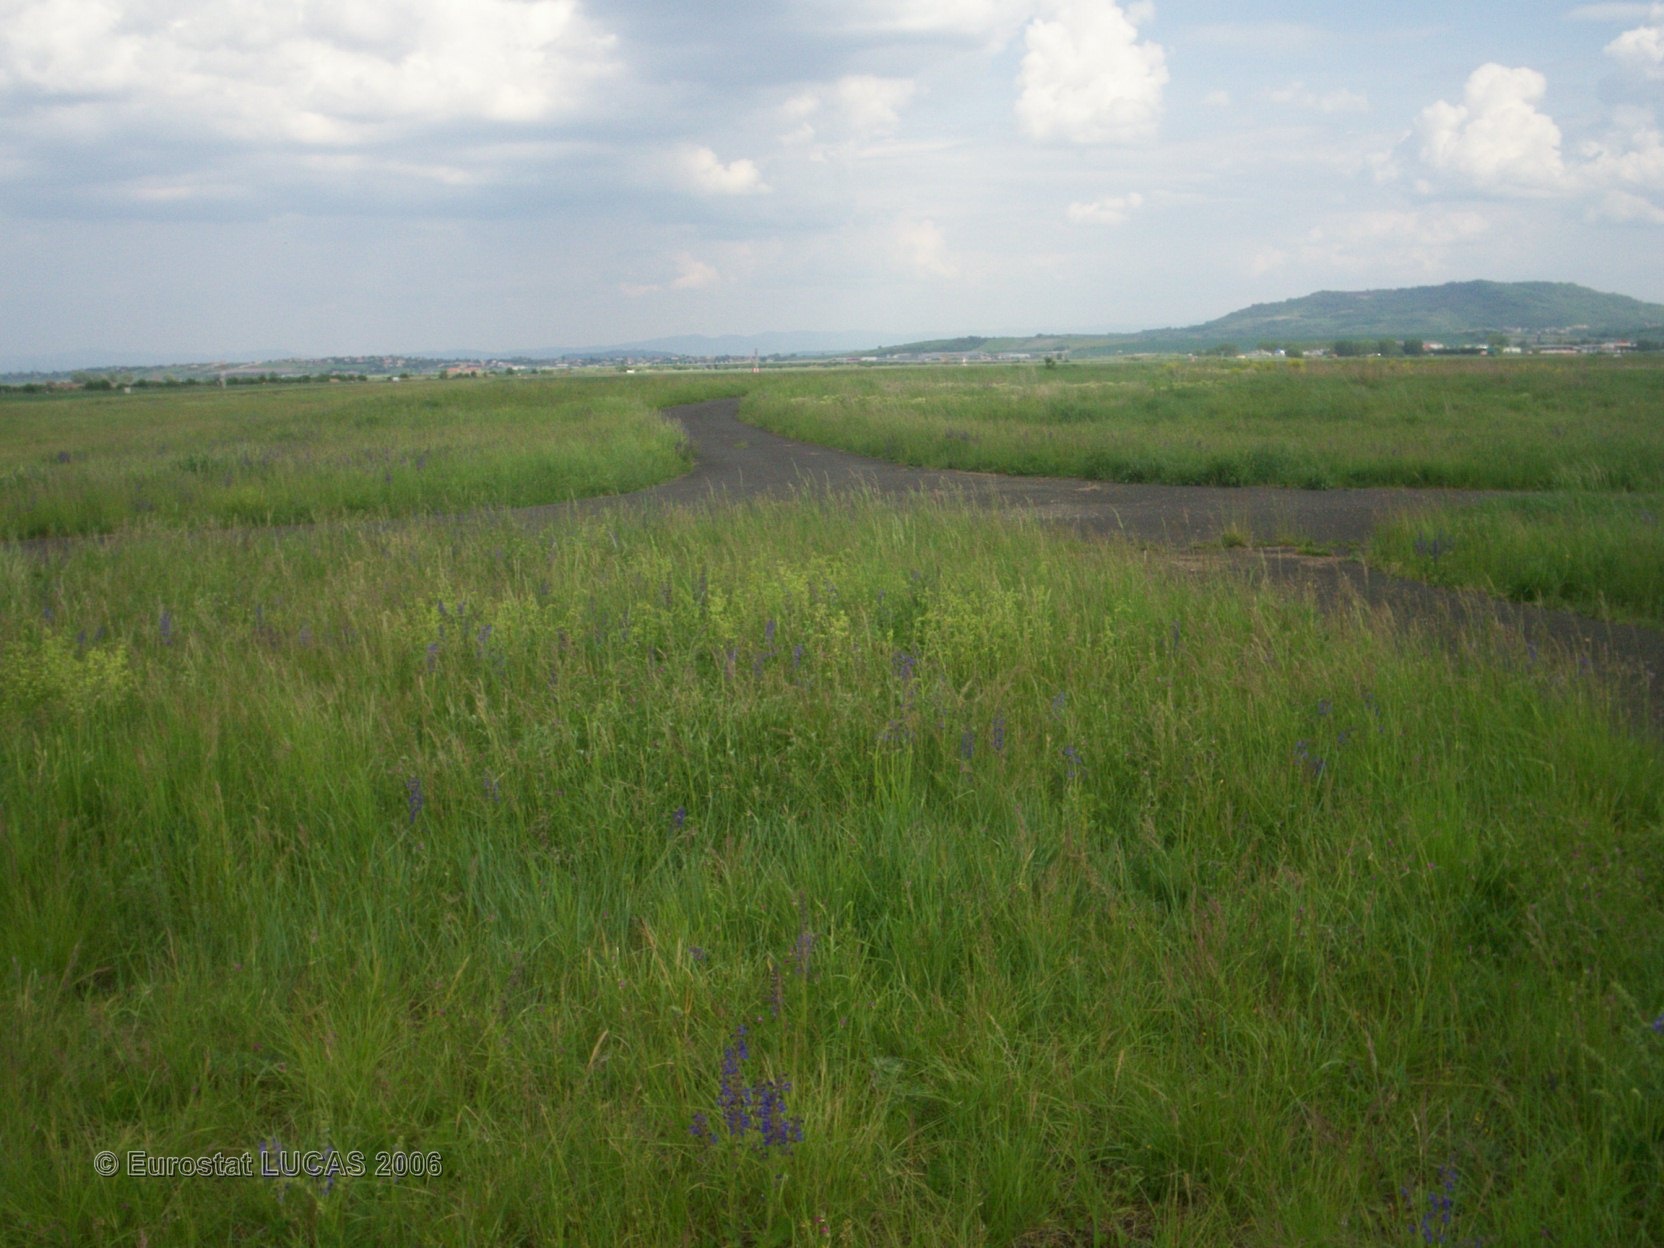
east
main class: Grassland
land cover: Grassland without tree/shrub cover
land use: Air transport
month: May
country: FR
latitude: 45.7893
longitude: 3.1693
